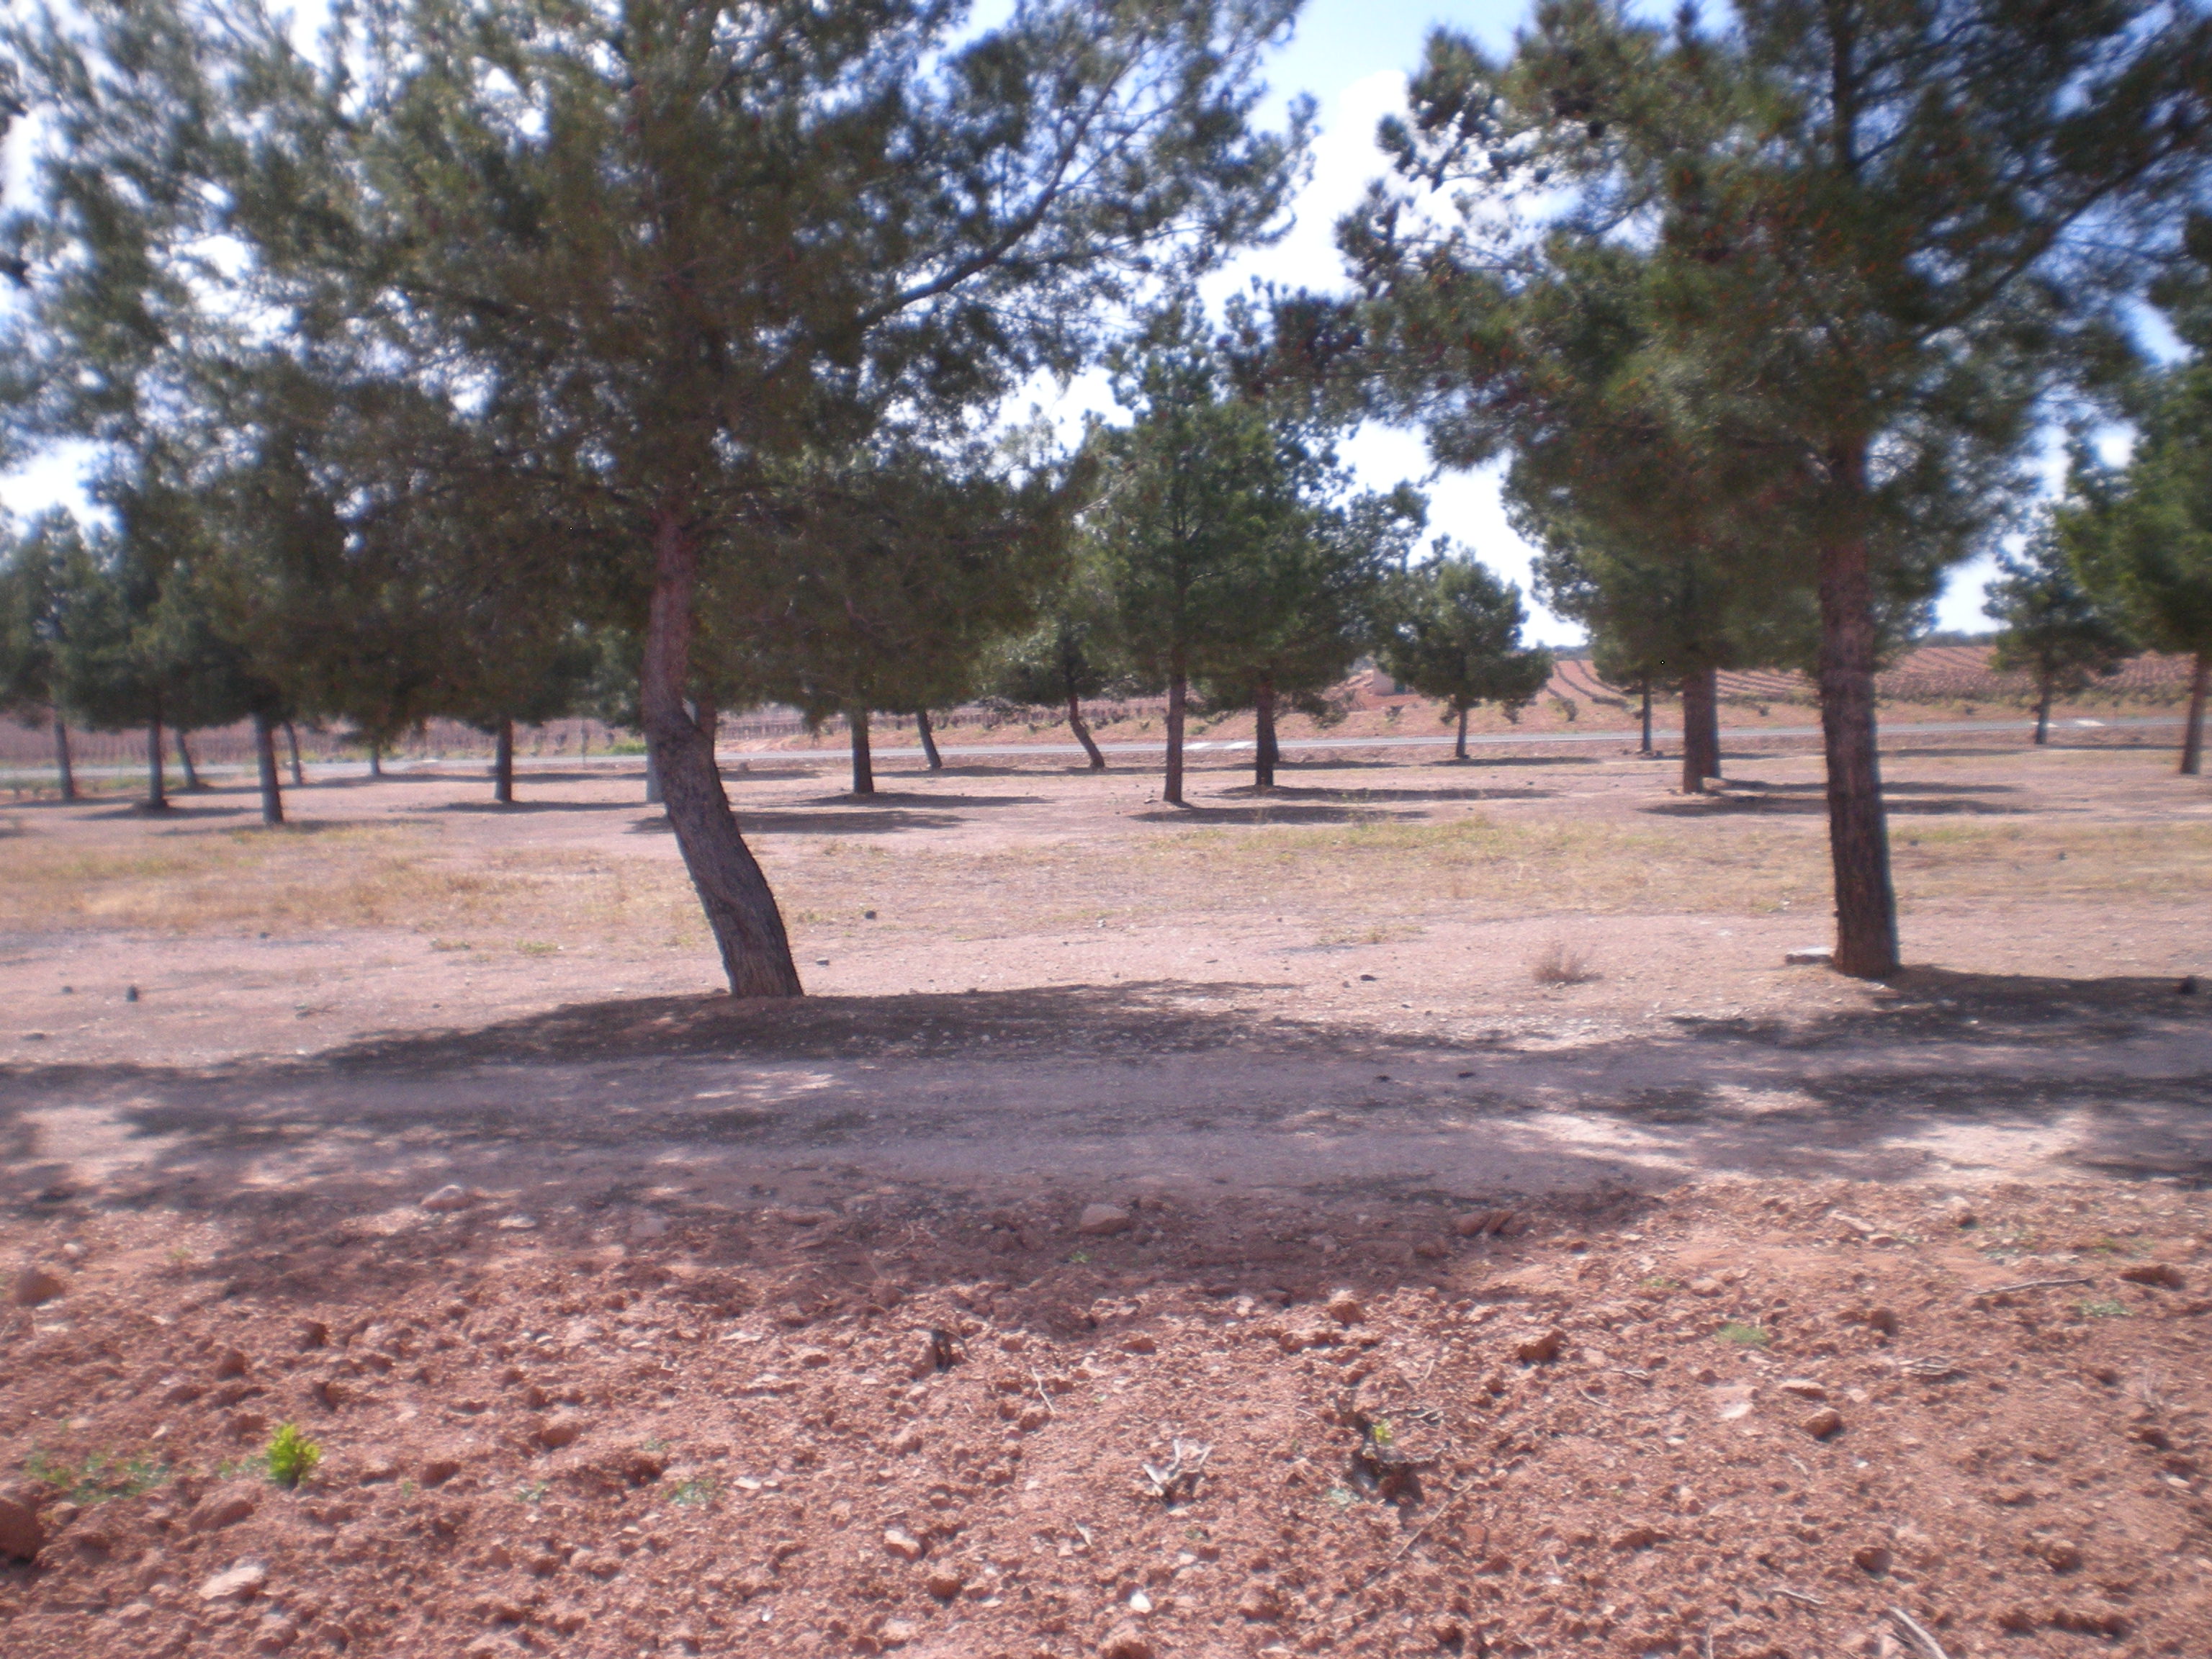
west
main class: Cropland
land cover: Vineyards
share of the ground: < 10 %
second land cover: Other bare soil
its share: > 75 %
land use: Agriculture (excluding fallow land and kitchen gardens)
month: April
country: ES
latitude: 38.7891
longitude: -3.5637
